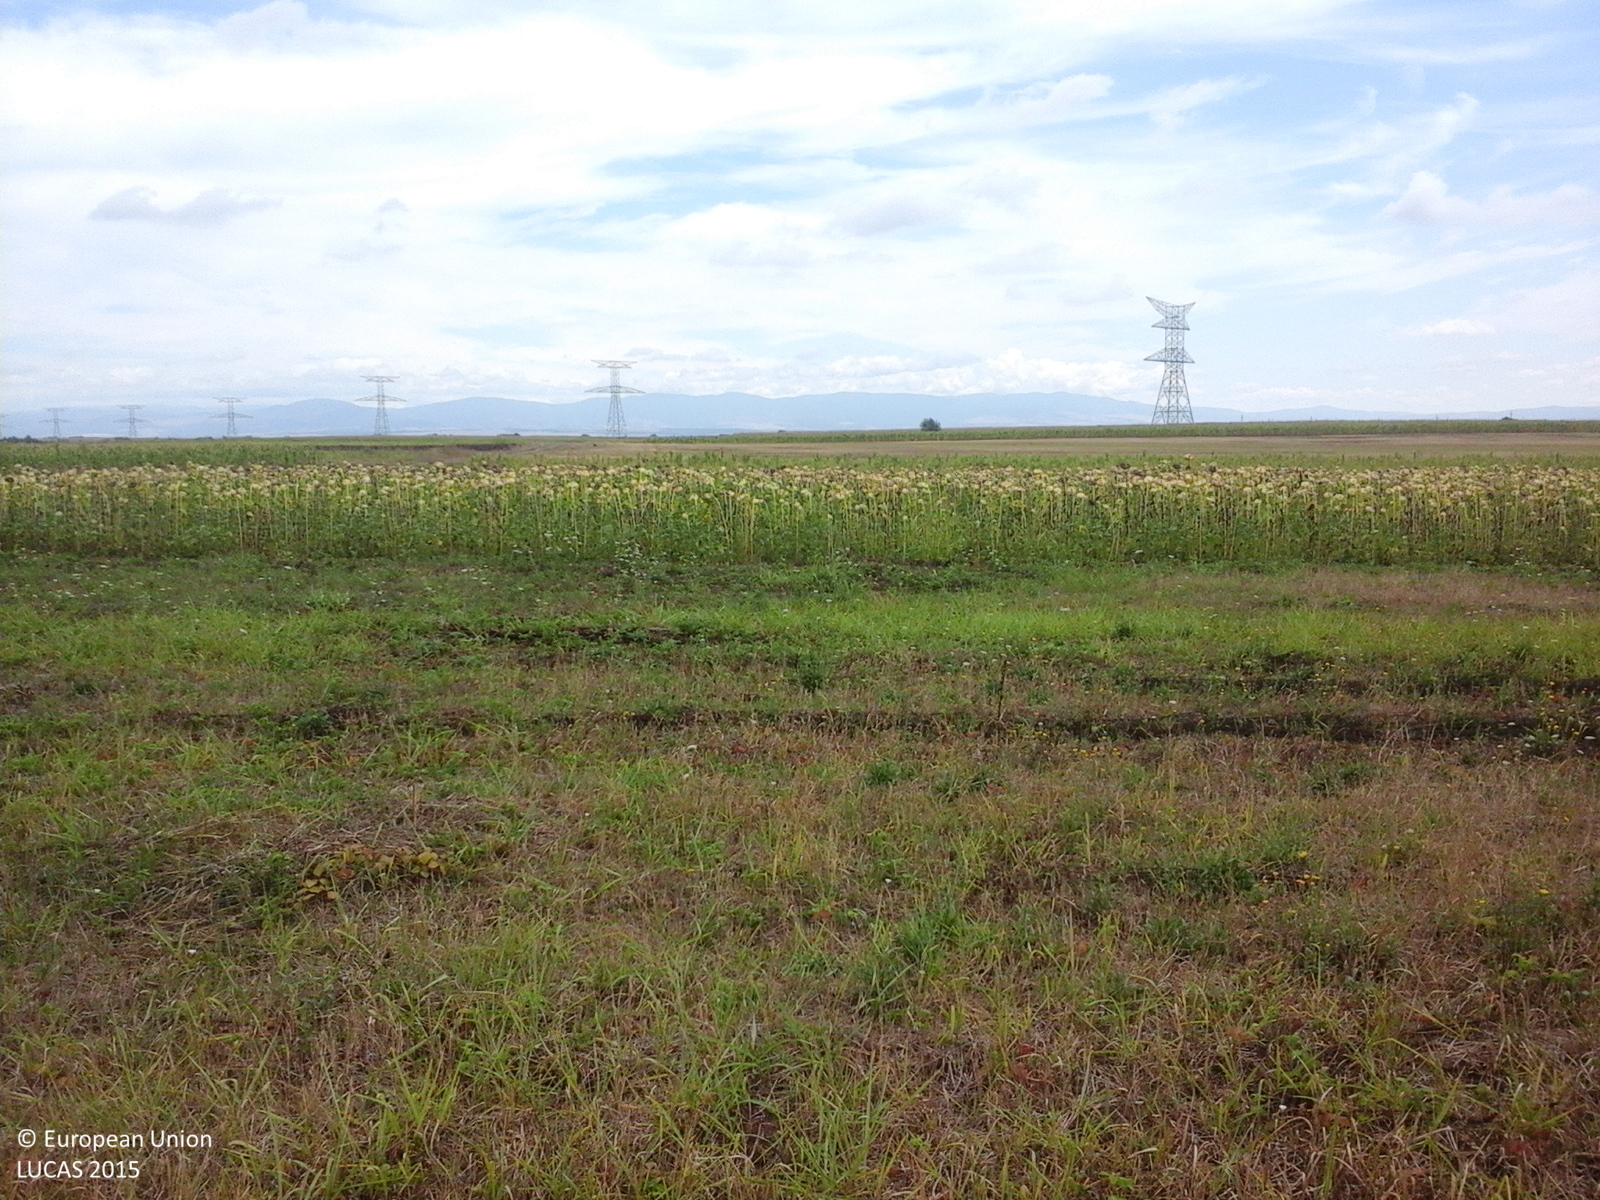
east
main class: Grassland
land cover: Grassland without tree/shrub cover
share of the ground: > 75 %
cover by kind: herbaceous plants 100 %
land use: Agriculture (excluding fallow land and kitchen gardens)
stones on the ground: < 10 %
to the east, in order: Grassland without tree/shrub cover; Sunflower; Spontaneously vegetated surfaces; Grassland without tree/shrub cover; Maize; Grassland without tree/shrub cover
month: August
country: RO
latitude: 45.0110
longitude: 21.4096
